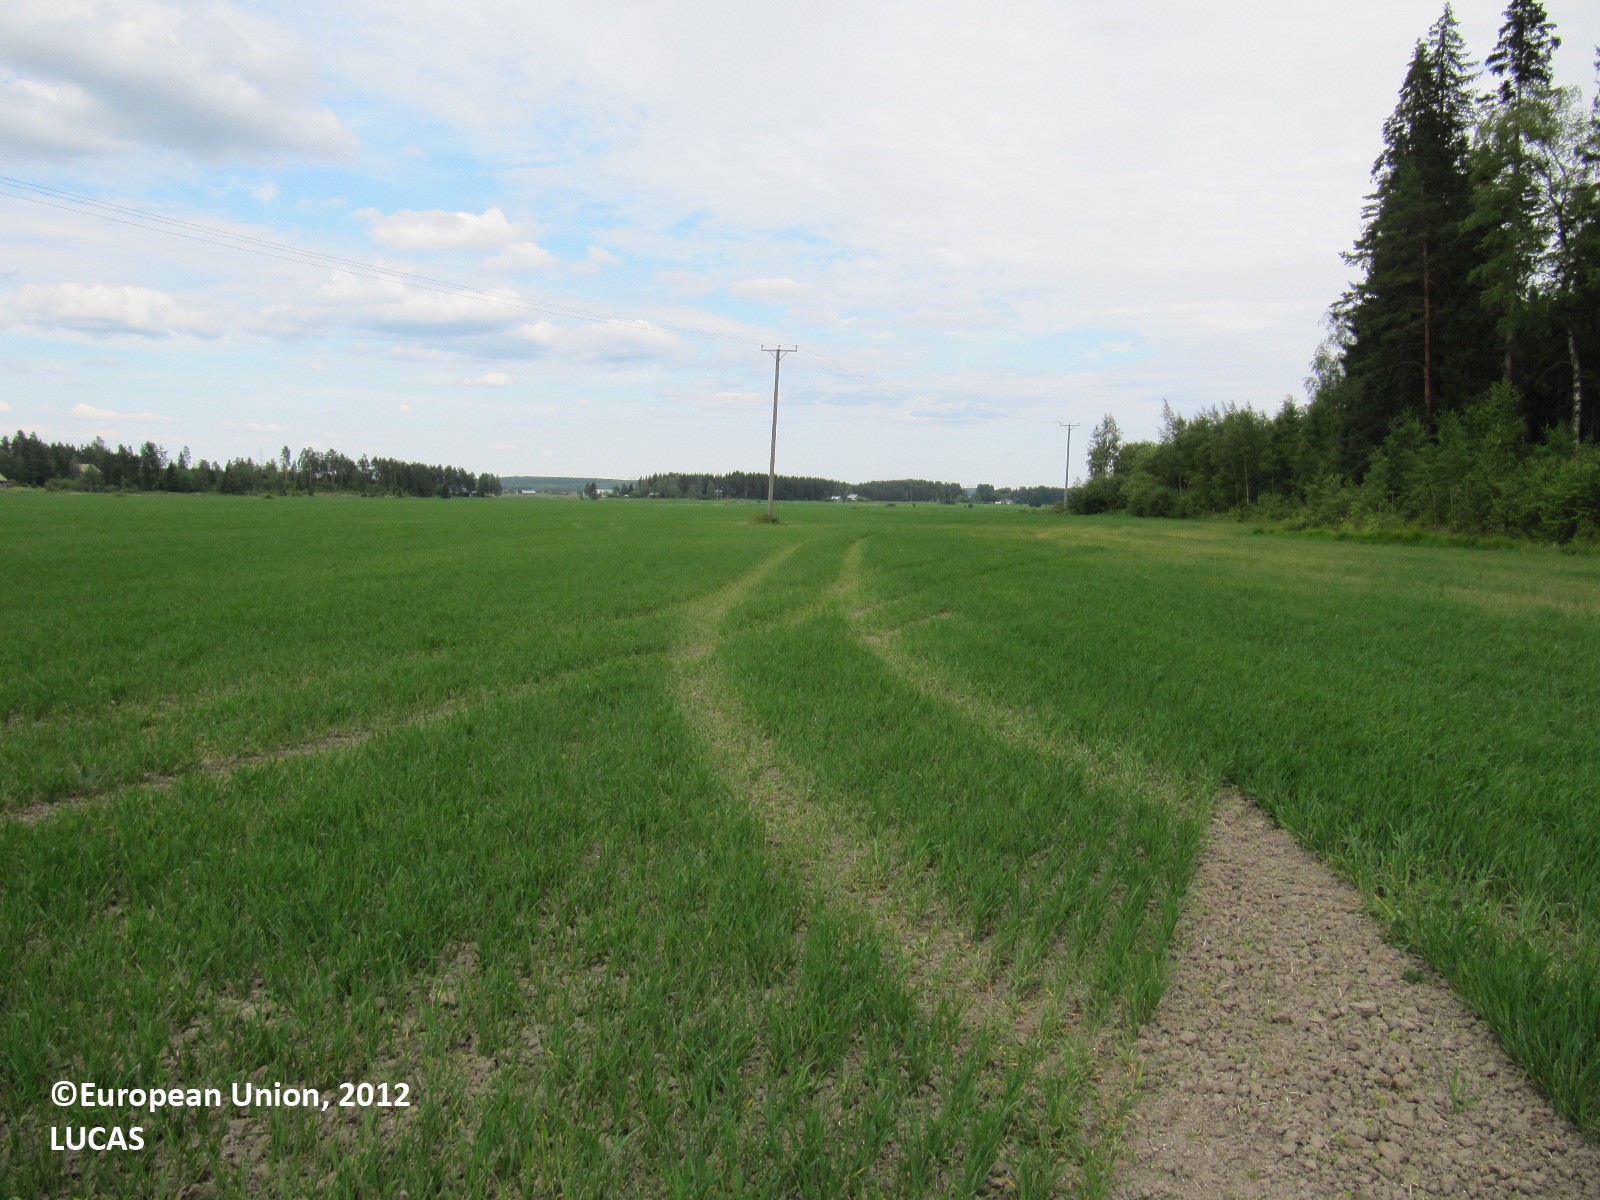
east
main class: Cropland
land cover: Barley
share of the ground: > 75 %
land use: Agriculture (excluding fallow land and kitchen gardens)
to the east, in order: Barley; Ditches and canals; Barley
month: July
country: FI
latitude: 60.8562
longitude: 23.3911
